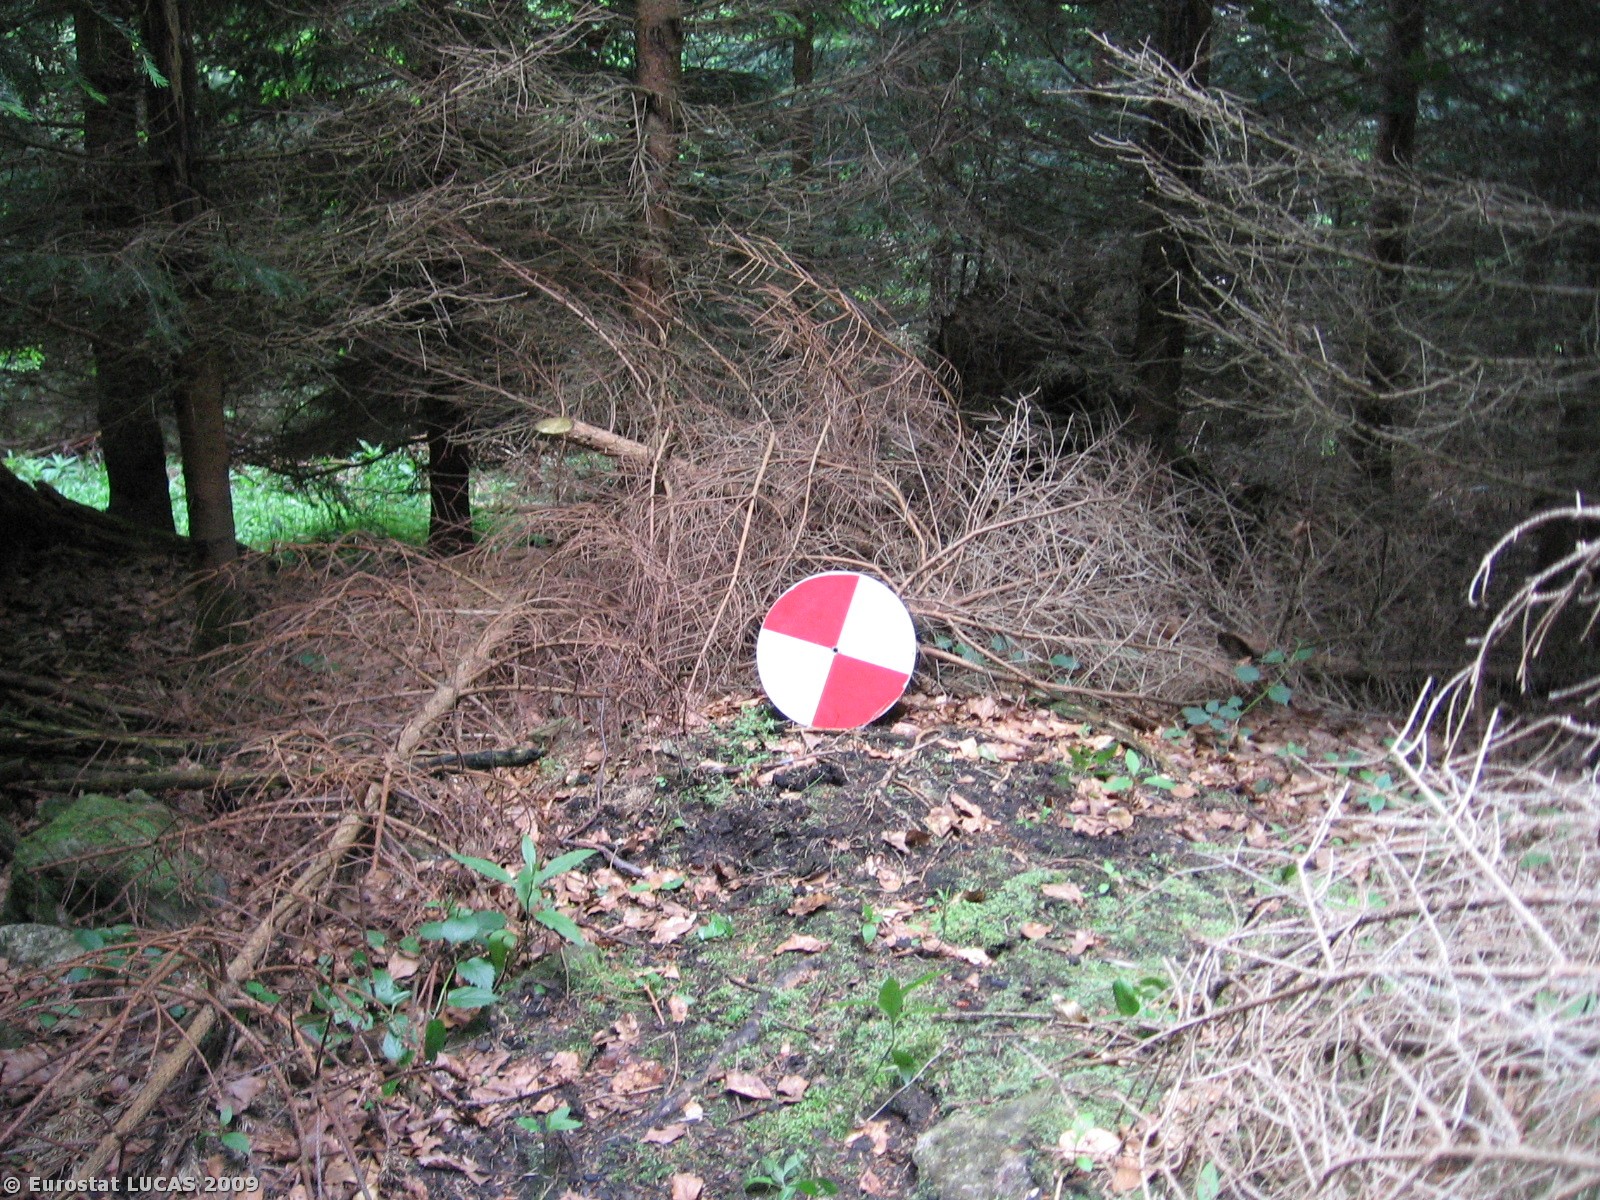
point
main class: Woodland
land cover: Coniferous woodland
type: hemiboreal forest and nemoral coniferous forest and mixed broadleaved-coniferous forest
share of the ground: > 75 %
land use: Forestry
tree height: > 5 m
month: June
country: CZ
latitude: 48.9673
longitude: 13.8386
